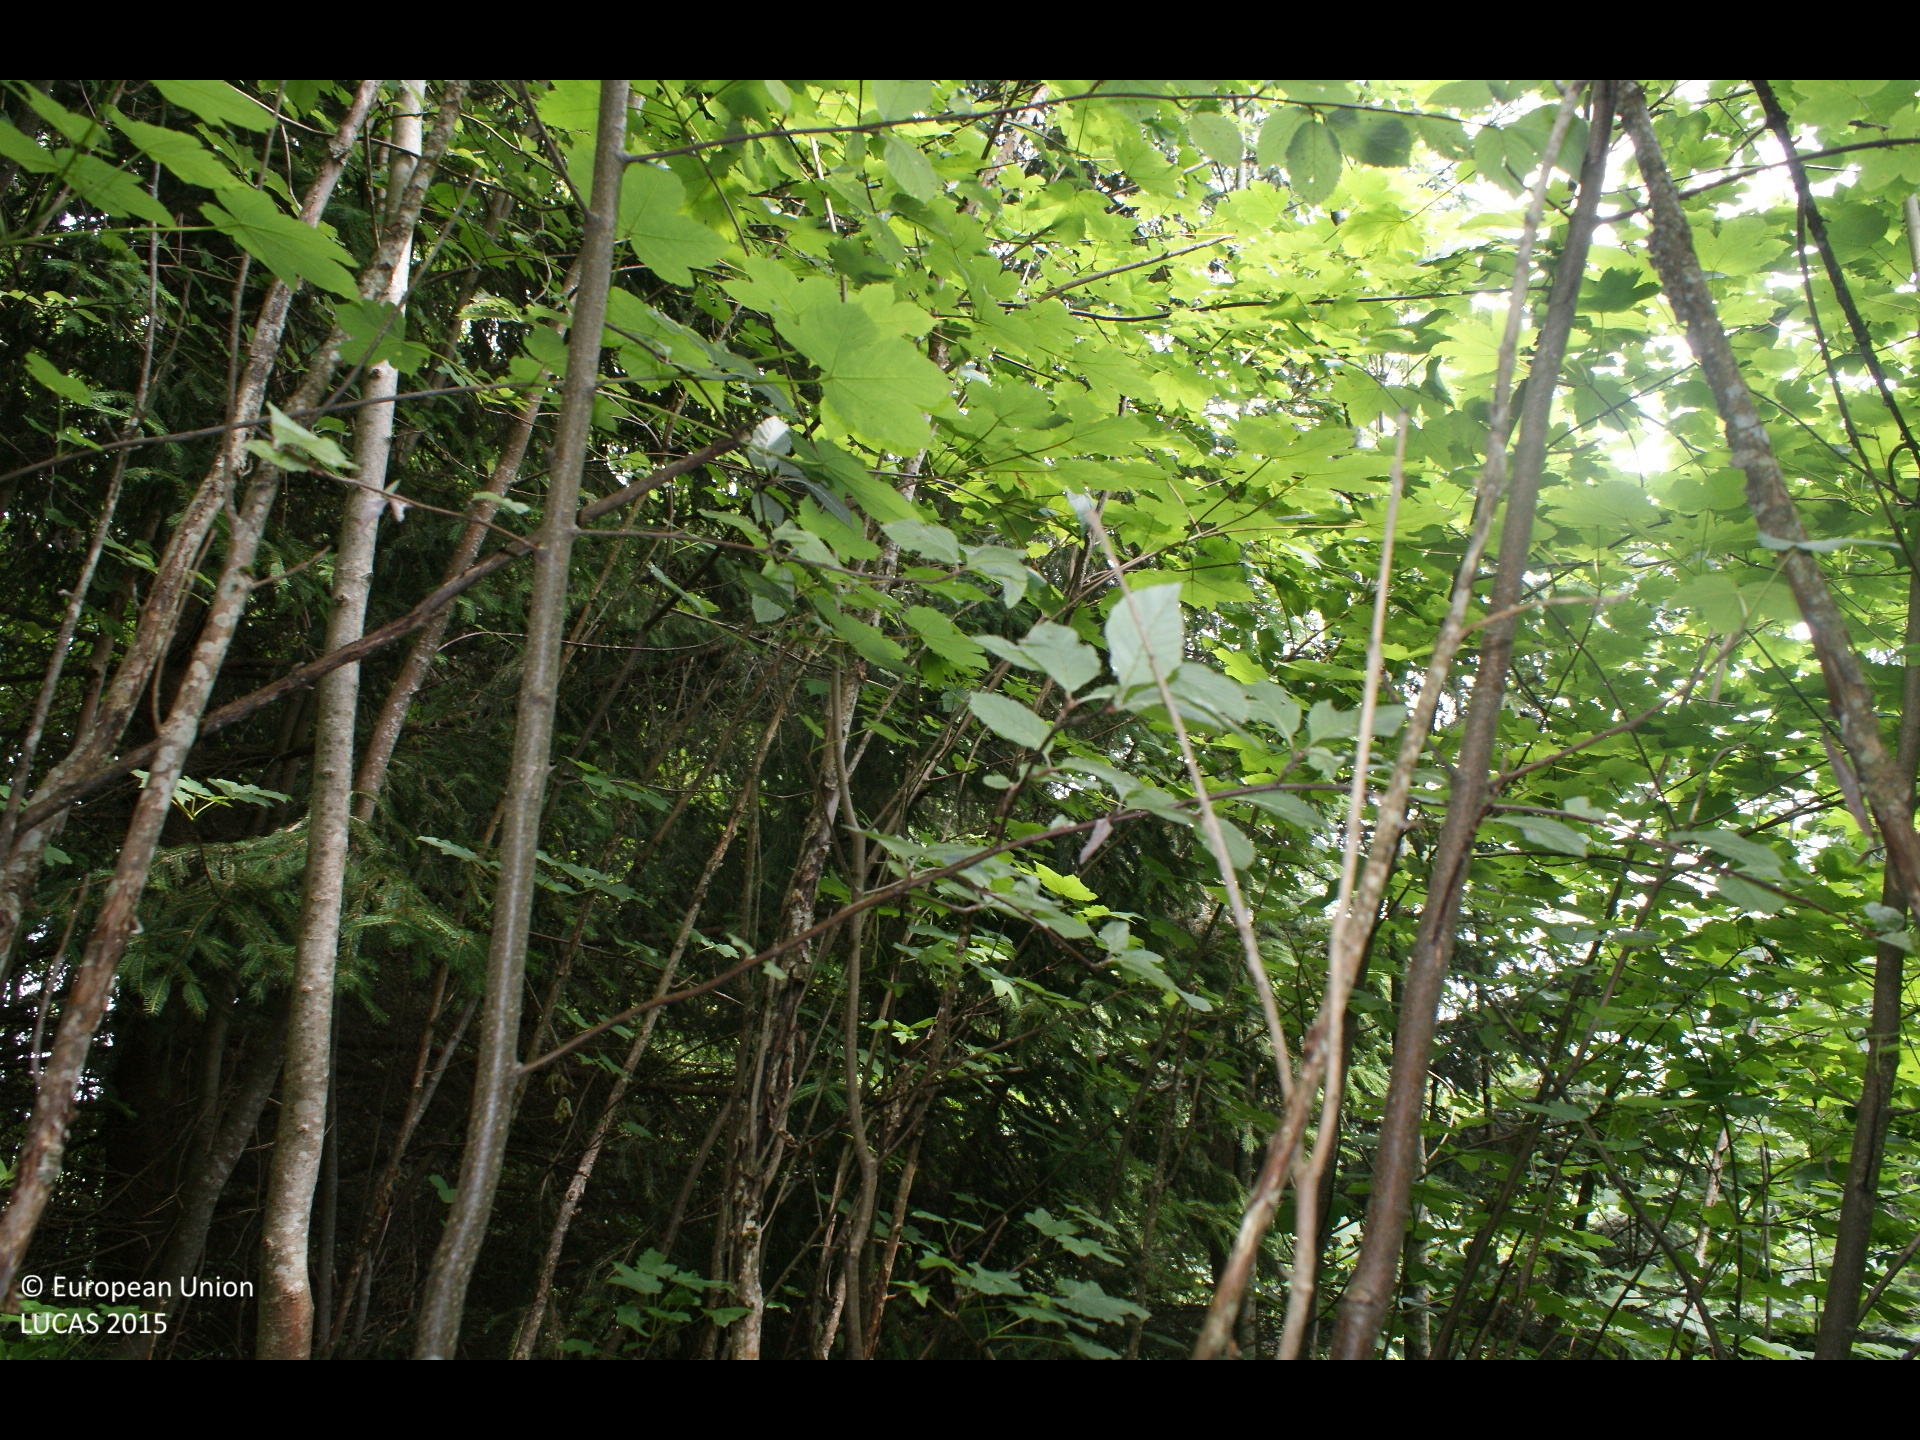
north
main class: Woodland
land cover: Broadleaved woodland
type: beech forest
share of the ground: > 75 %
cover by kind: broadleaved forest trees 90 %, coniferous forest trees 5 %, herbaceous plants 5 %
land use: Forestry
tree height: < 5 m
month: June
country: AT
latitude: 47.9405
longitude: 14.3238
